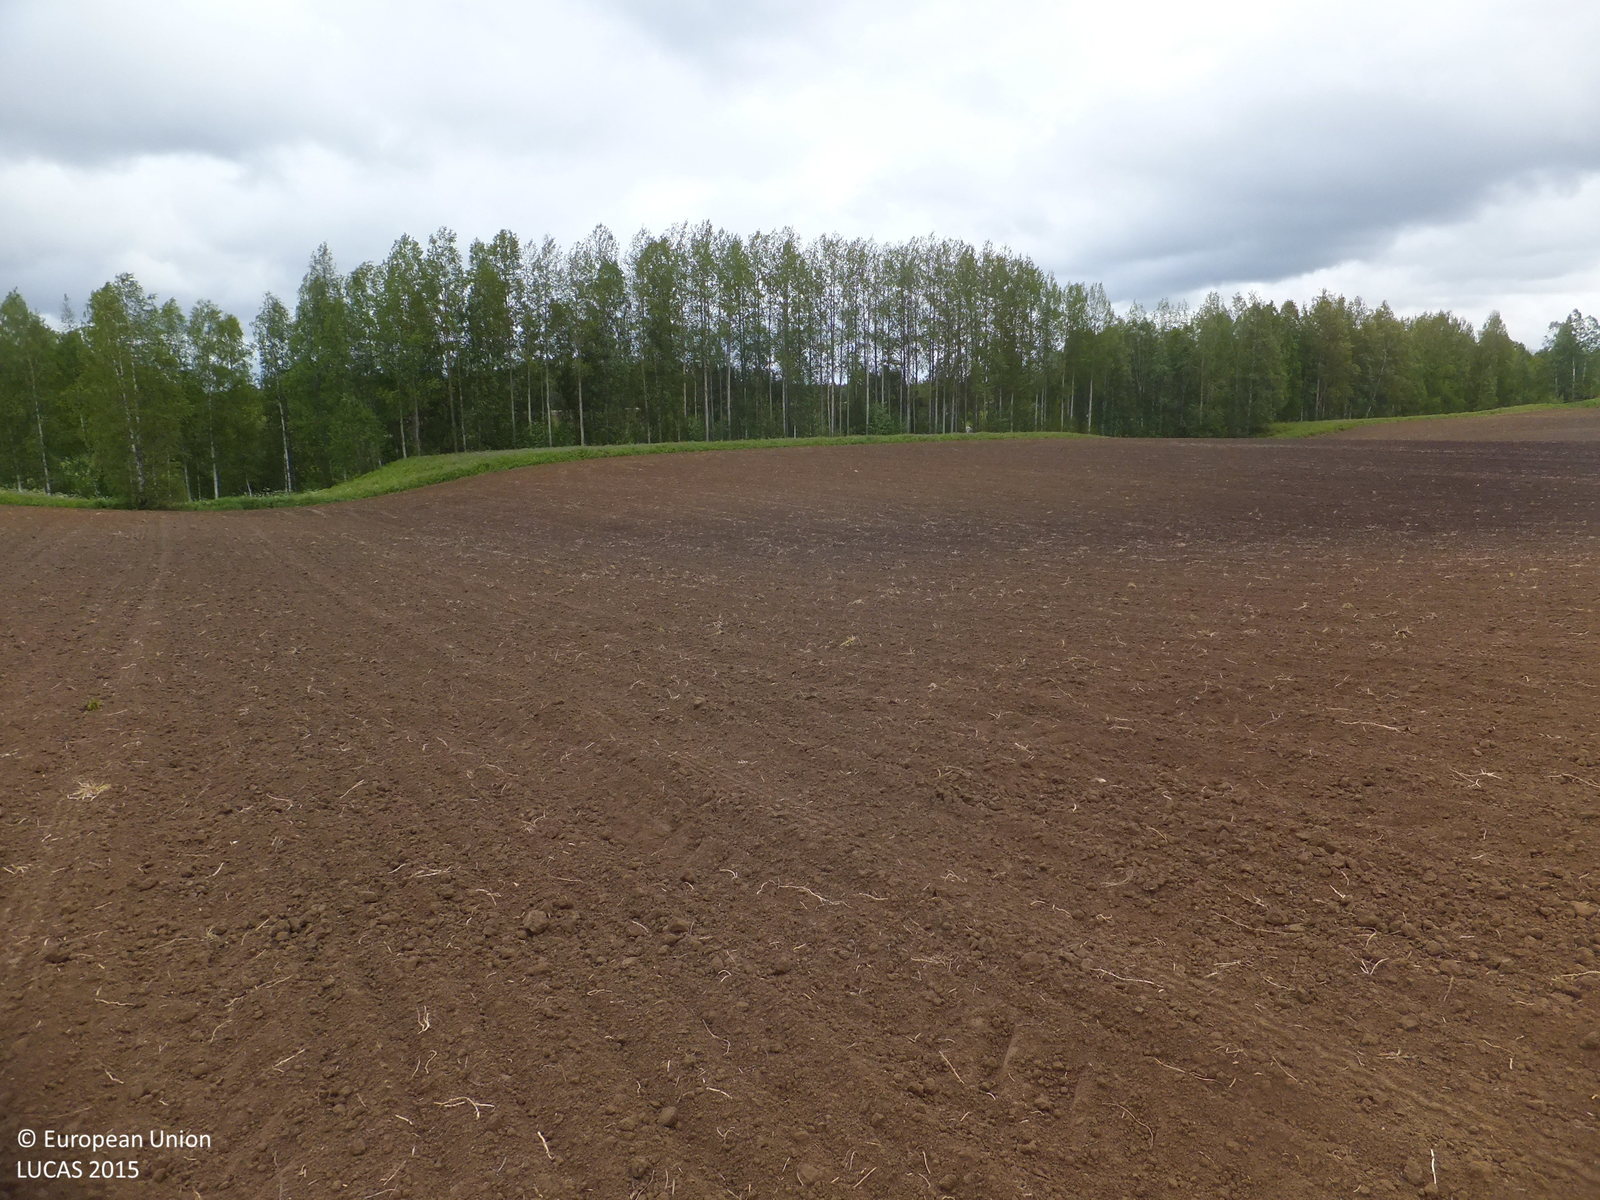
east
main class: Cropland
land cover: Rape and turnip rape
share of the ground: < 10 %
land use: Agriculture (excluding fallow land and kitchen gardens)
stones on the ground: < 10 %
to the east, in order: Rape and turnip rape; Grassland without tree/shrub cover; Broadleaved woodland; Inland fresh running water; Other mixed woodland; Grassland without tree/shrub cover; Other bare soil
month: June
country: FI
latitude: 63.6455
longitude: 24.3914
